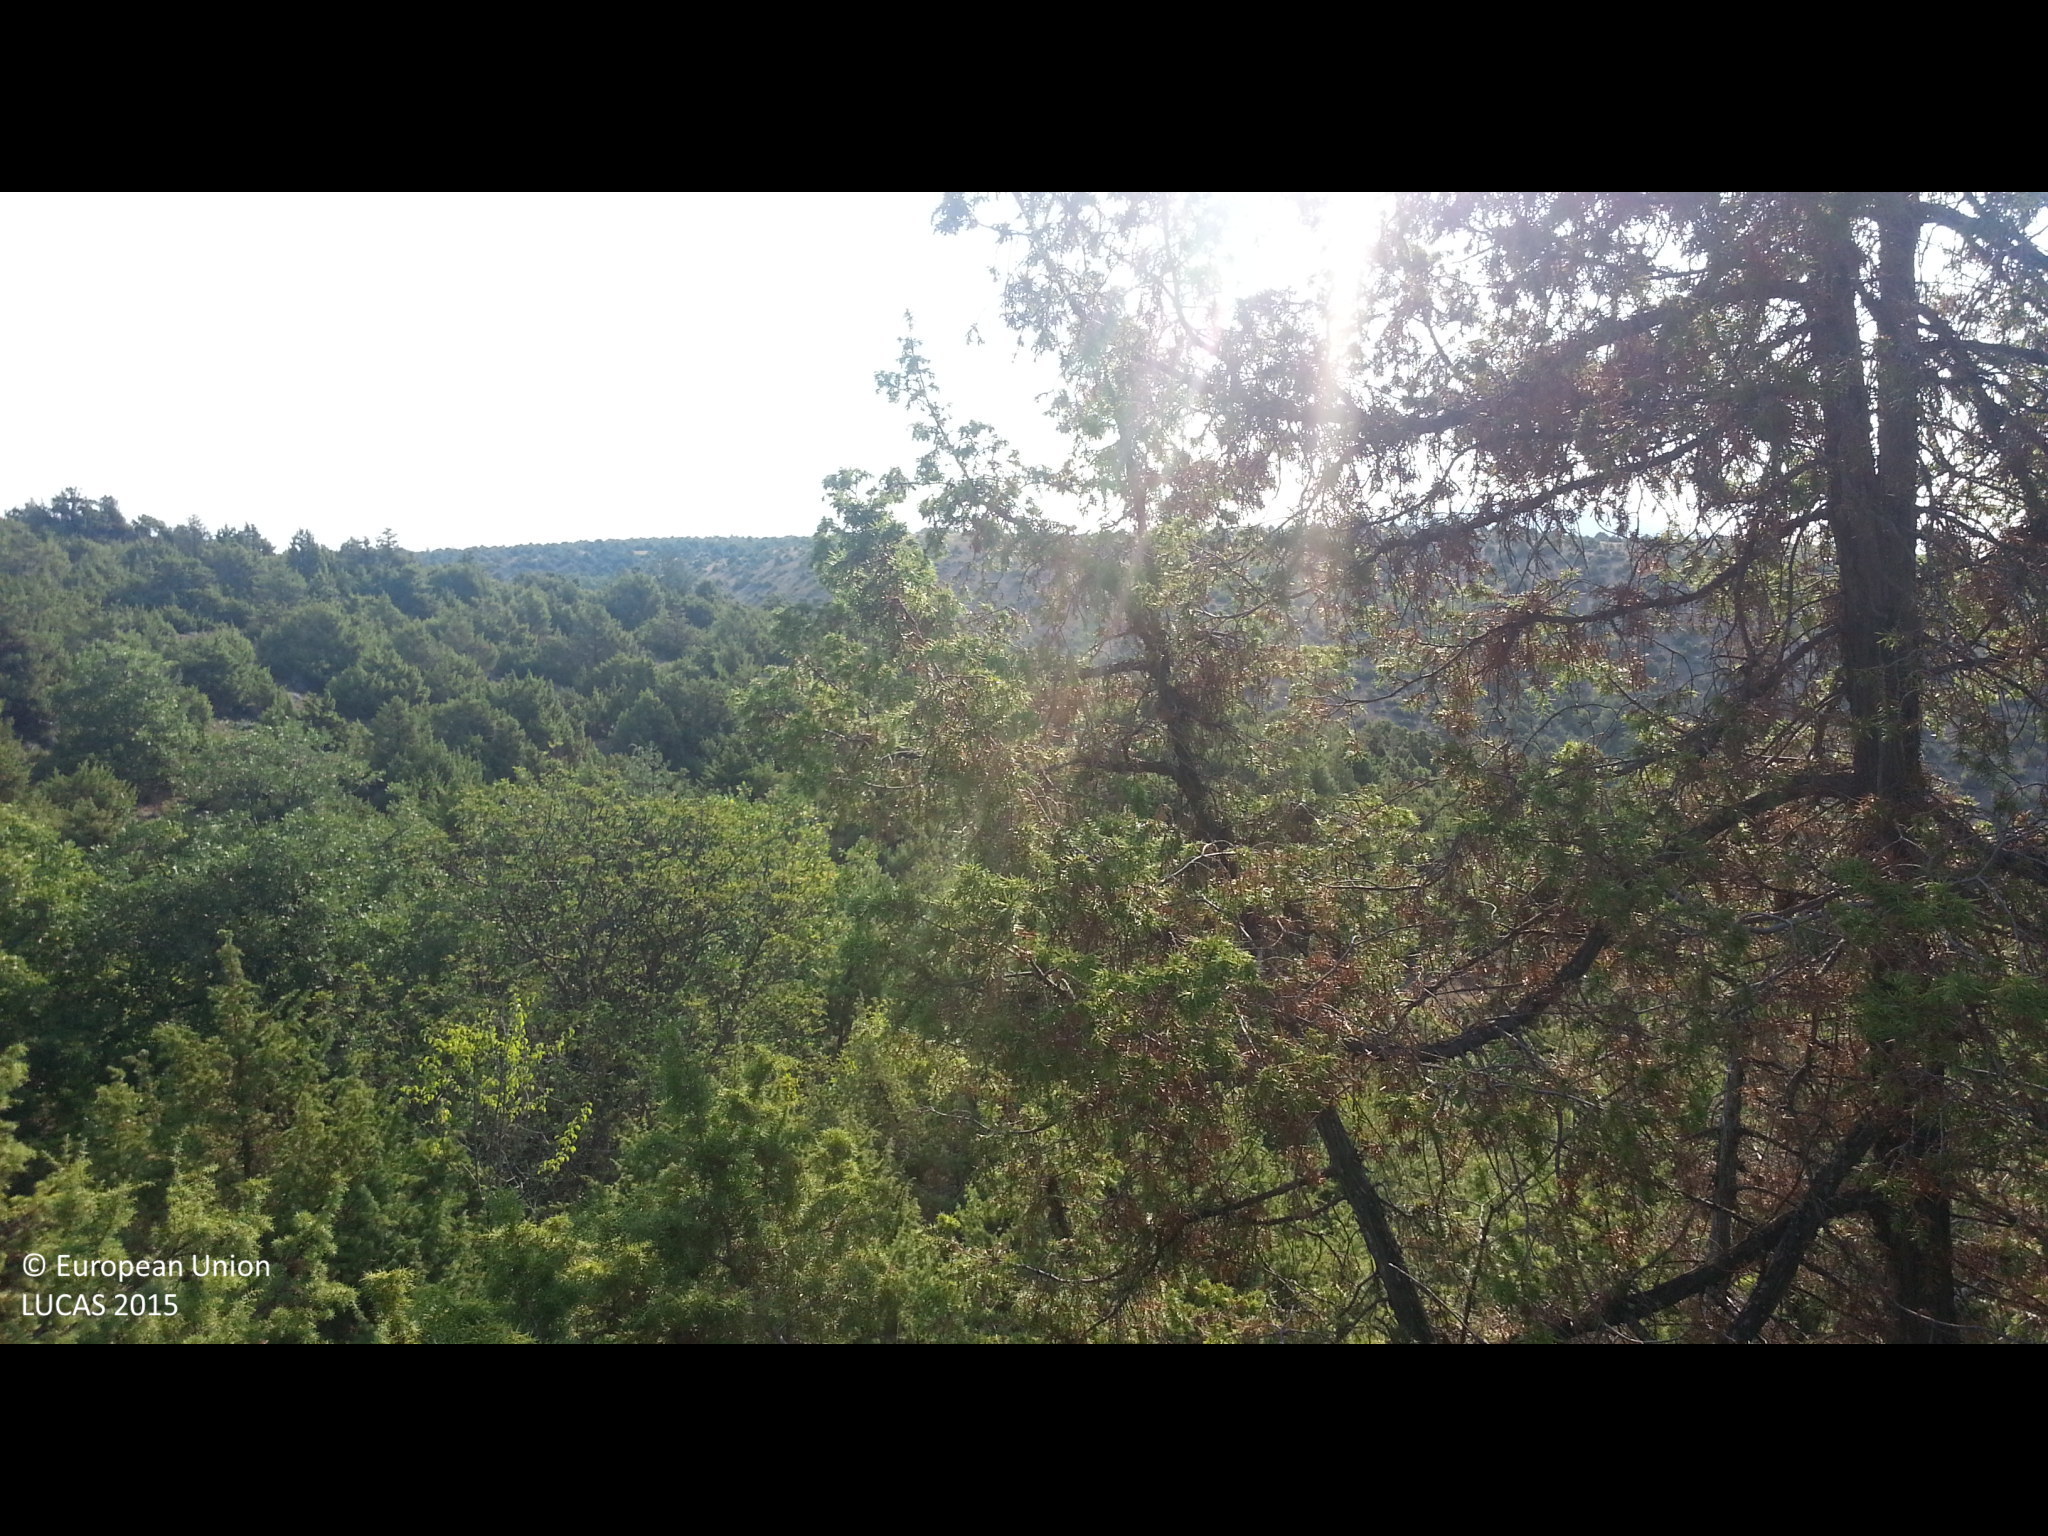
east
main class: Shrubland
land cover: Shrubland with sparse tree cover
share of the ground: > 75 %
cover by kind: shrubs 75 %, herbaceous plants 20 %, broadleaved forest trees 5 %
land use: Semi-natural and natural areas not in use
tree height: < 5 m
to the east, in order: Shrubland with sparse tree cover; Rivers and streams; Shrubland with sparse tree cover
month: August
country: BG
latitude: 42.4233
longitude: 22.6502
